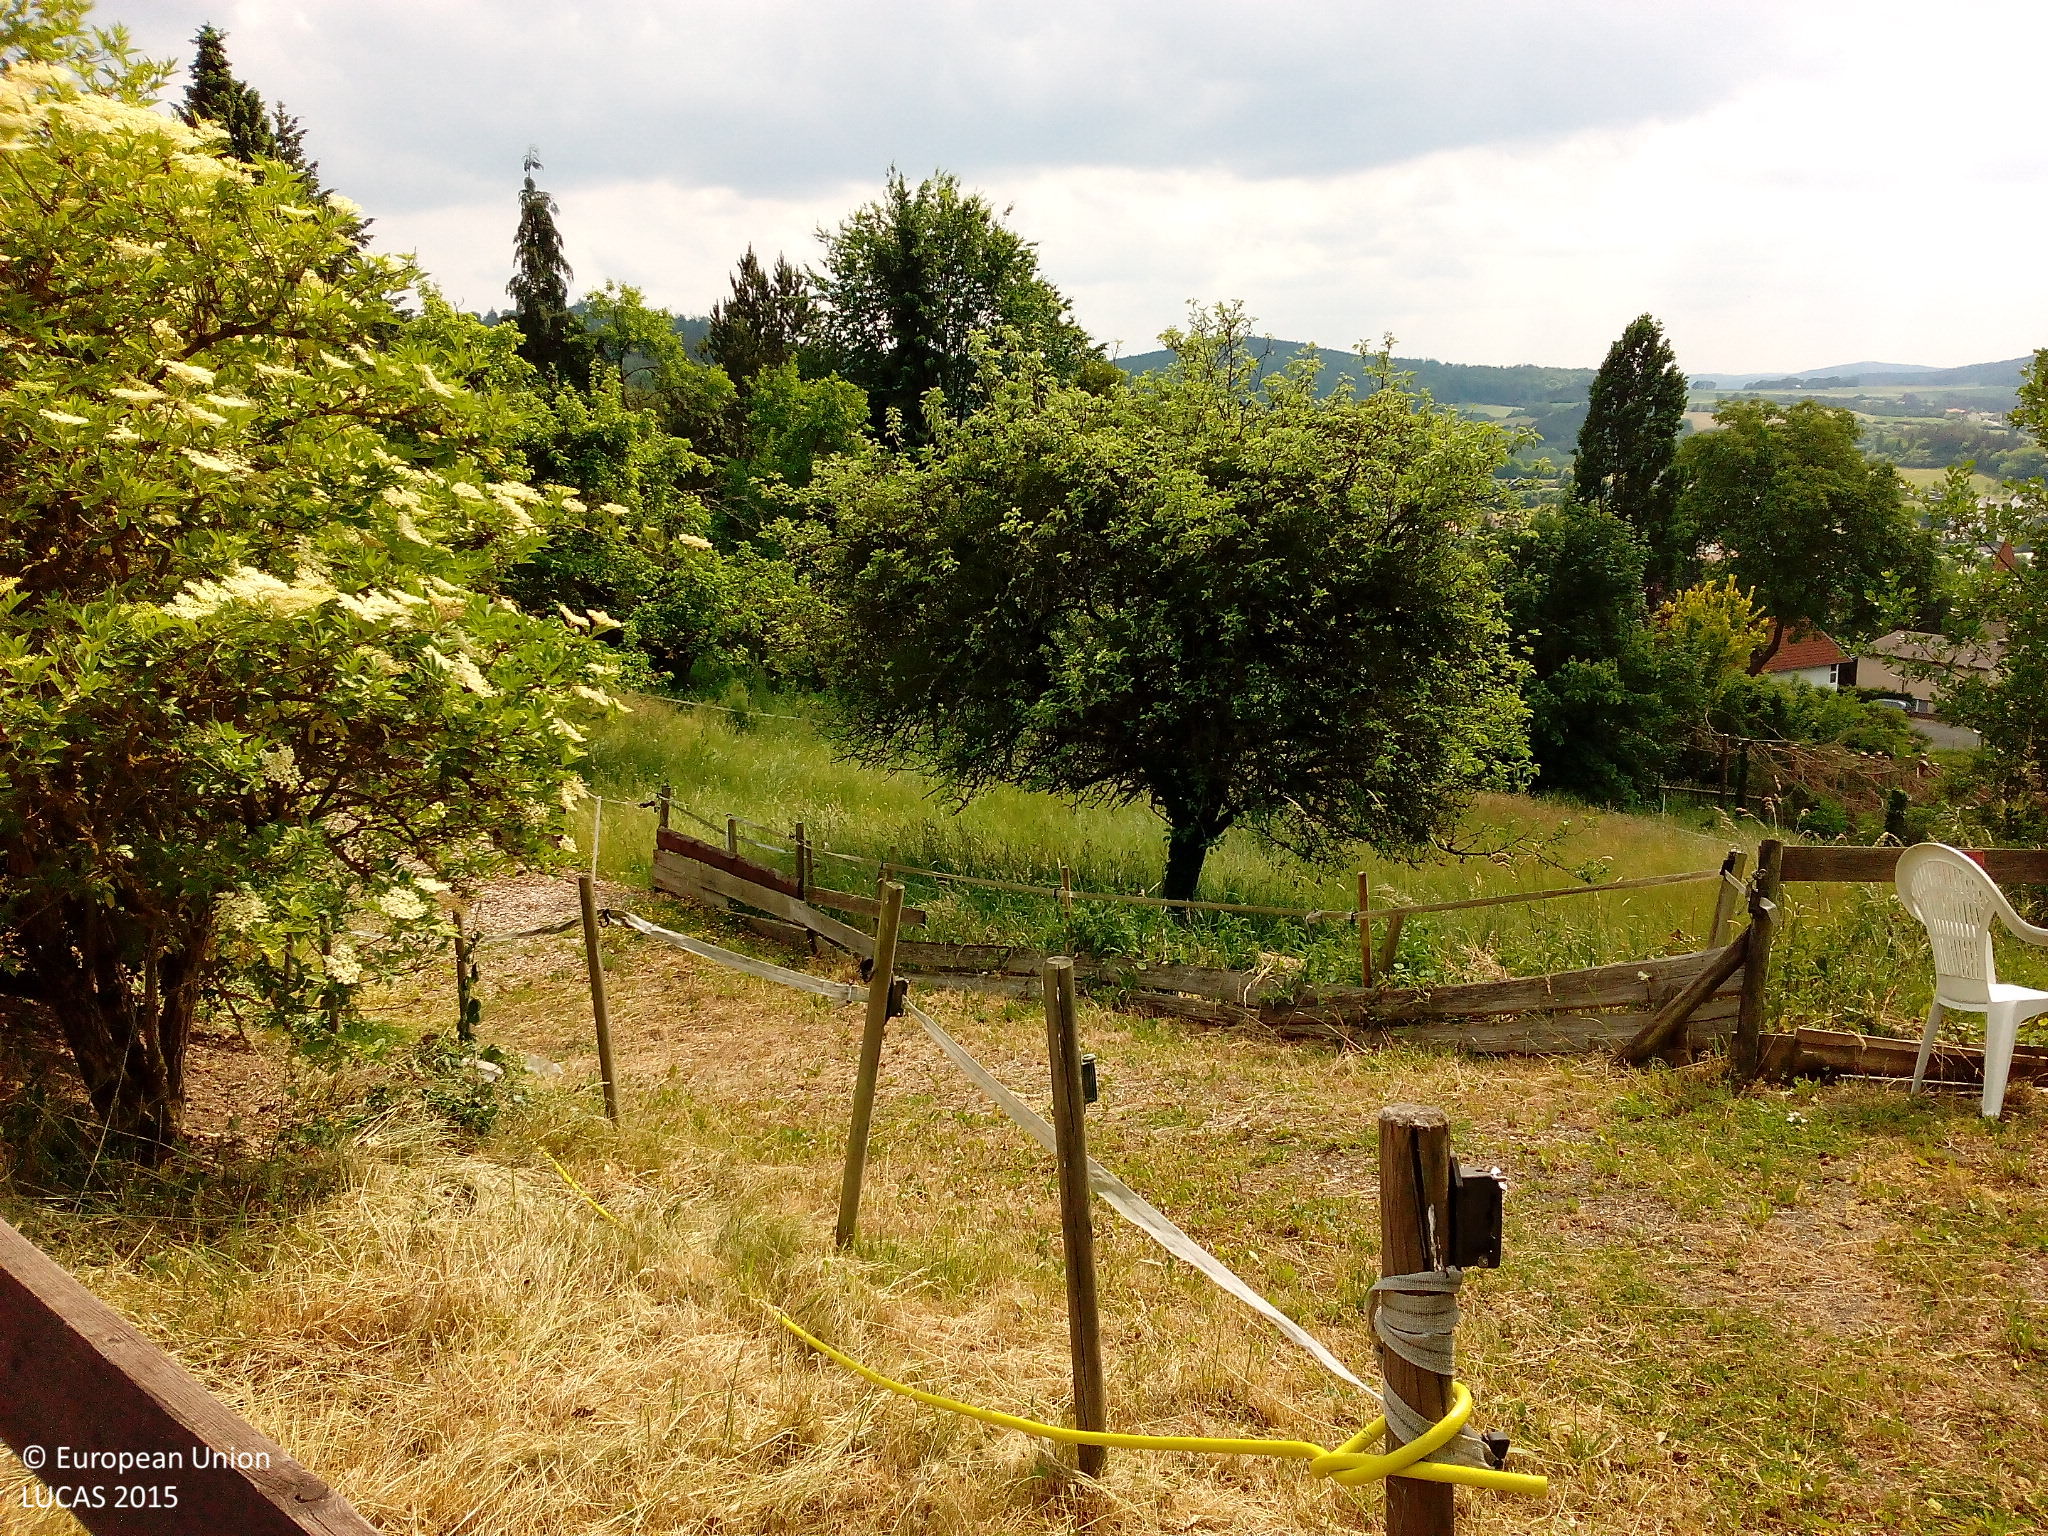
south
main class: Cropland
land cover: Apple fruit
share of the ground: 50 - 75 %
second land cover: Grassland without tree/shrub cover
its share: > 75 %
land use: Agriculture (excluding fallow land and kitchen gardens)
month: June
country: DE
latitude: 51.1187
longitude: 9.6715
